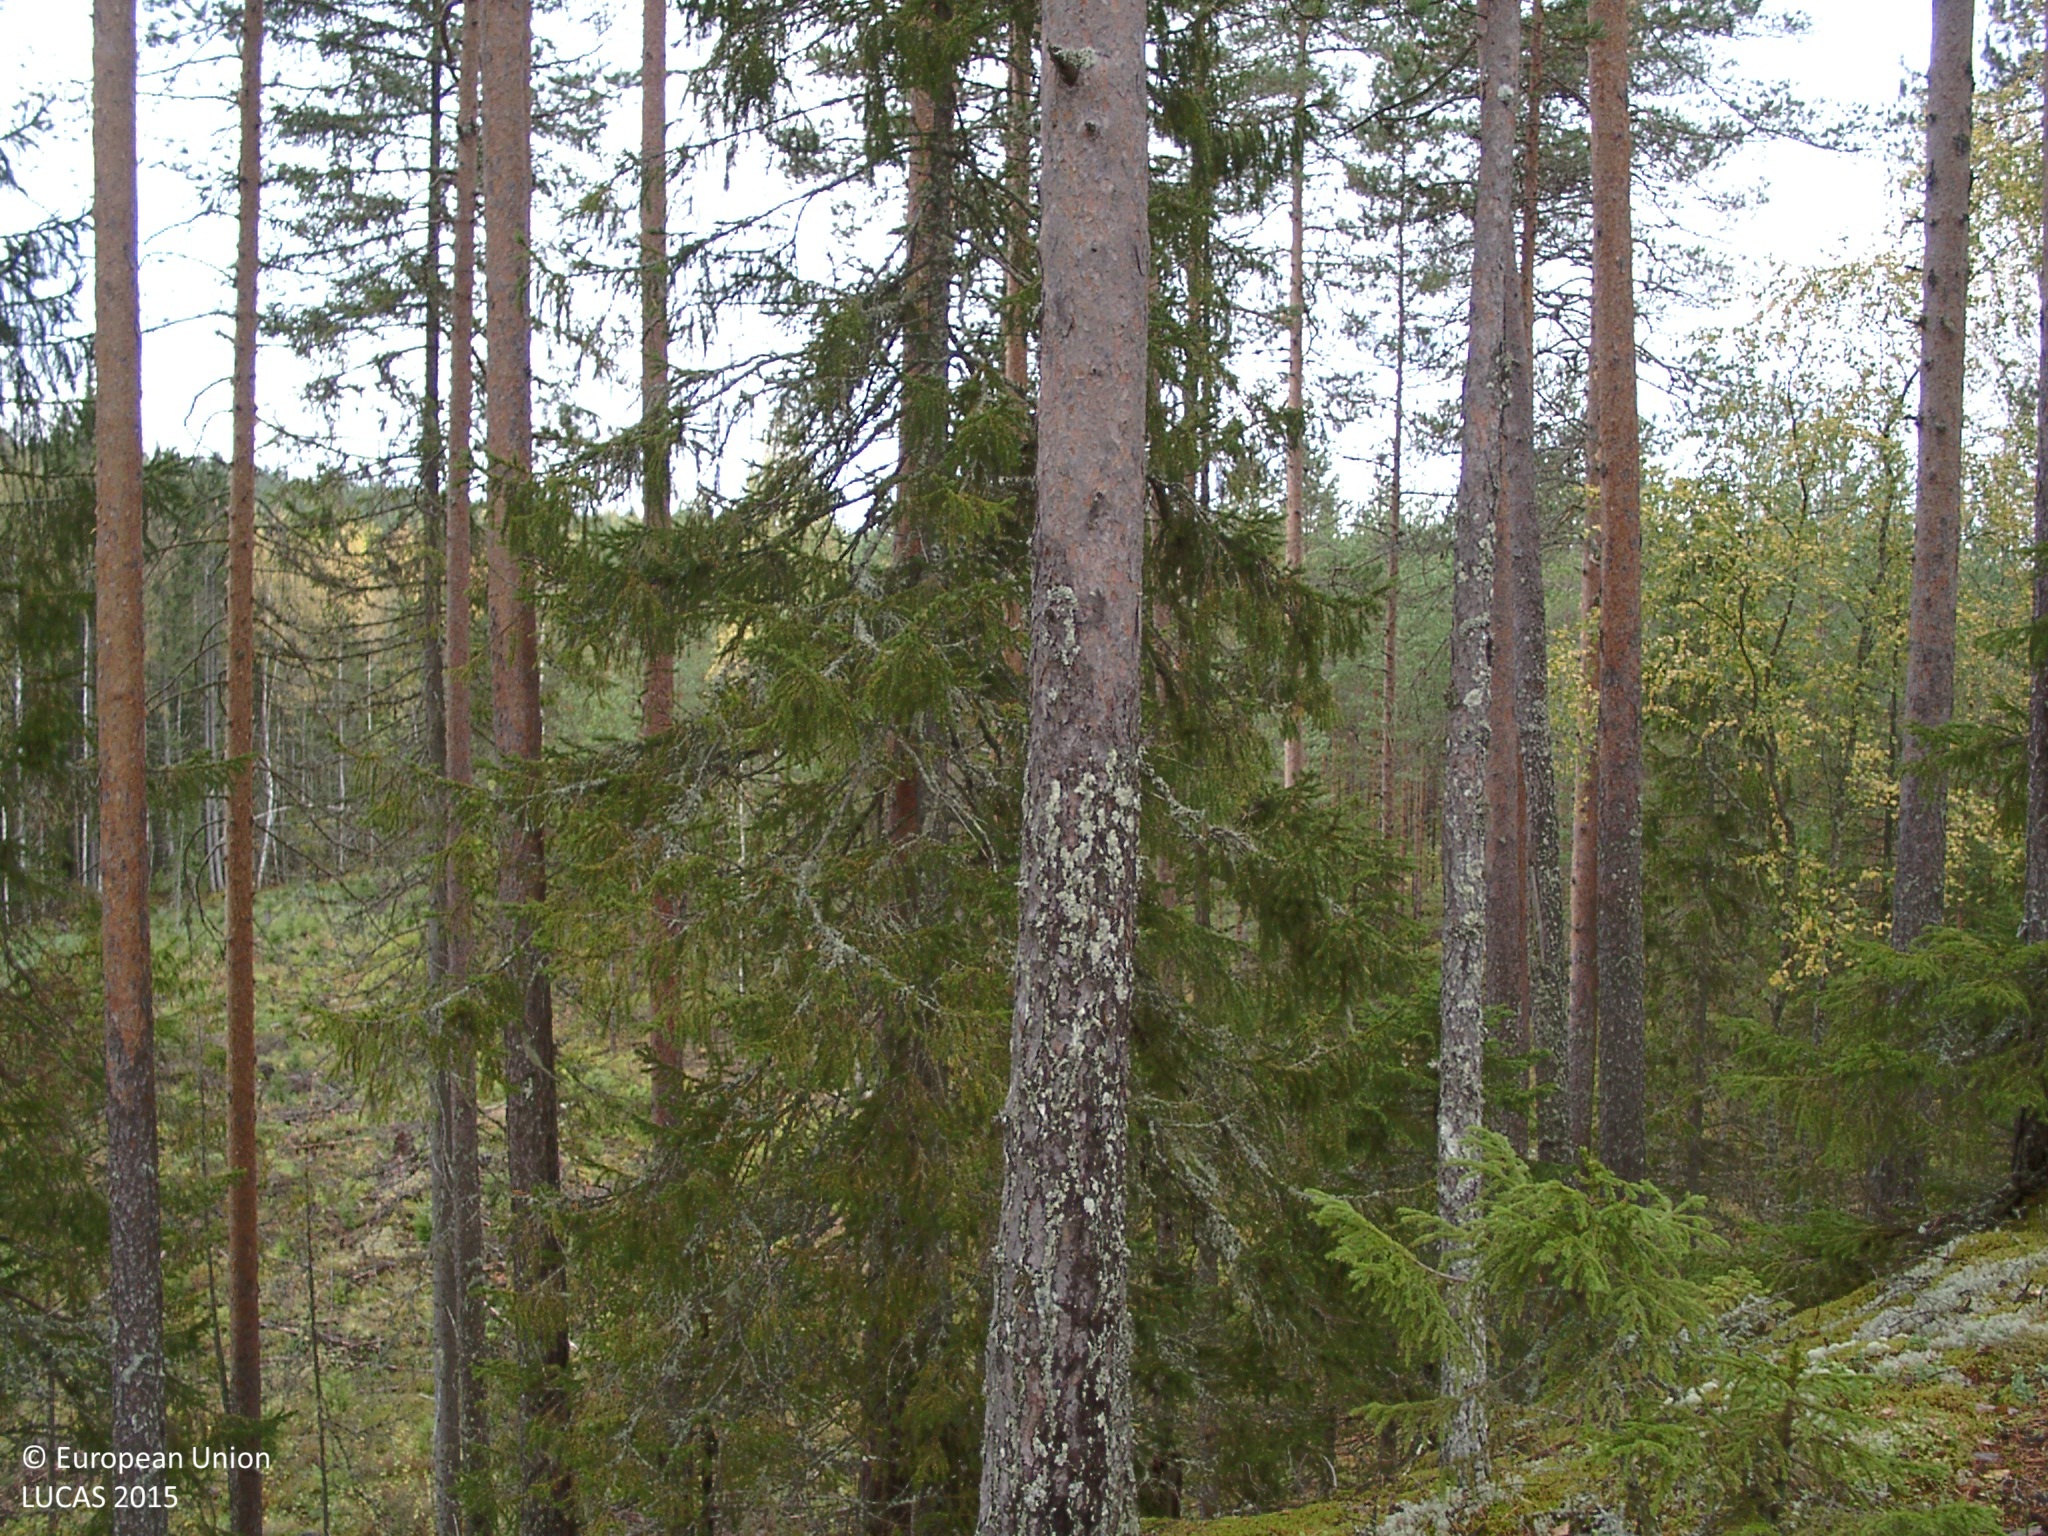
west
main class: Woodland
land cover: Pine dominated coniferous woodland
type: boreal forest
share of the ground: 50 - 75 %
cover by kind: coniferous forest trees 60 %, lichens and mosses 25 %, shrubs 15 %
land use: Forestry
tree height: > 5 m
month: September
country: FI
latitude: 62.7791
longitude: 25.3310
